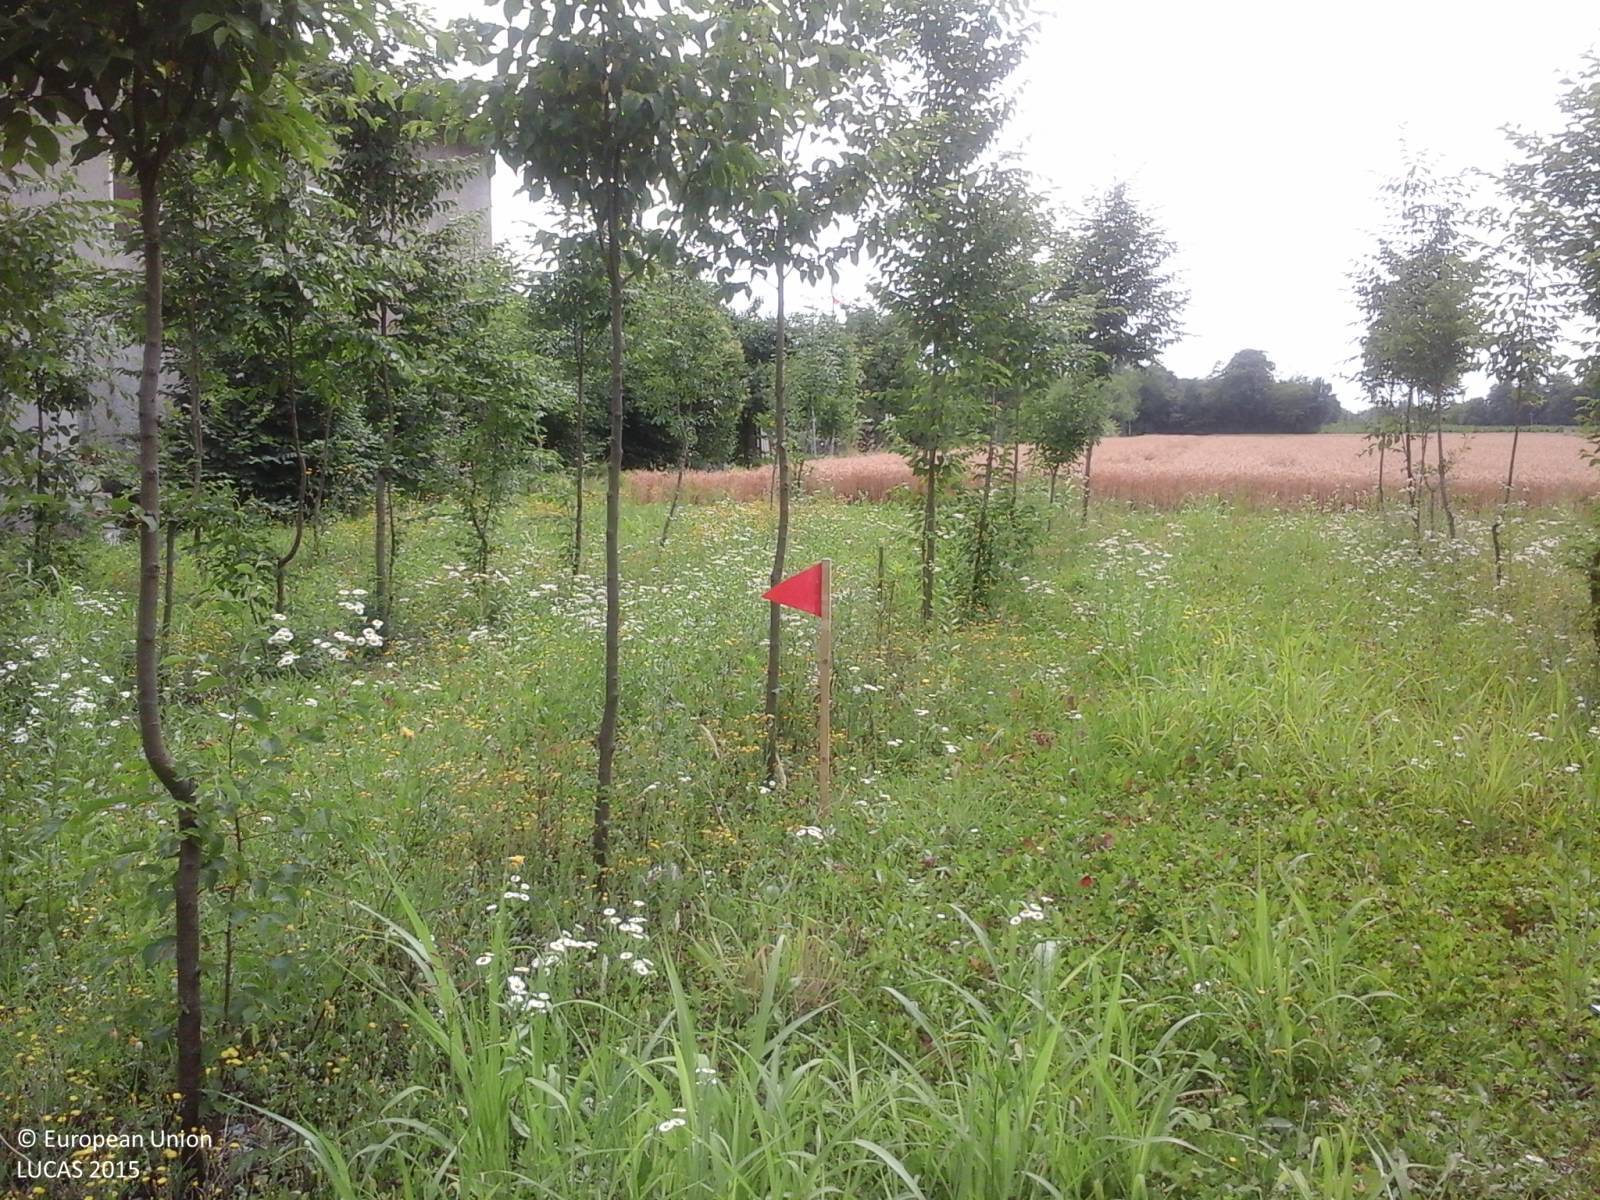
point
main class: Woodland
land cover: Broadleaved woodland
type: mesophytic deciduous forest
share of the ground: 50 - 75 %
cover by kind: broadleaved forest trees 55 %, herbaceous plants 40 %, shrubs 5 %
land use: Forestry
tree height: < 5 m
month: June
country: IT
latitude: 46.0475
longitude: 12.6719
